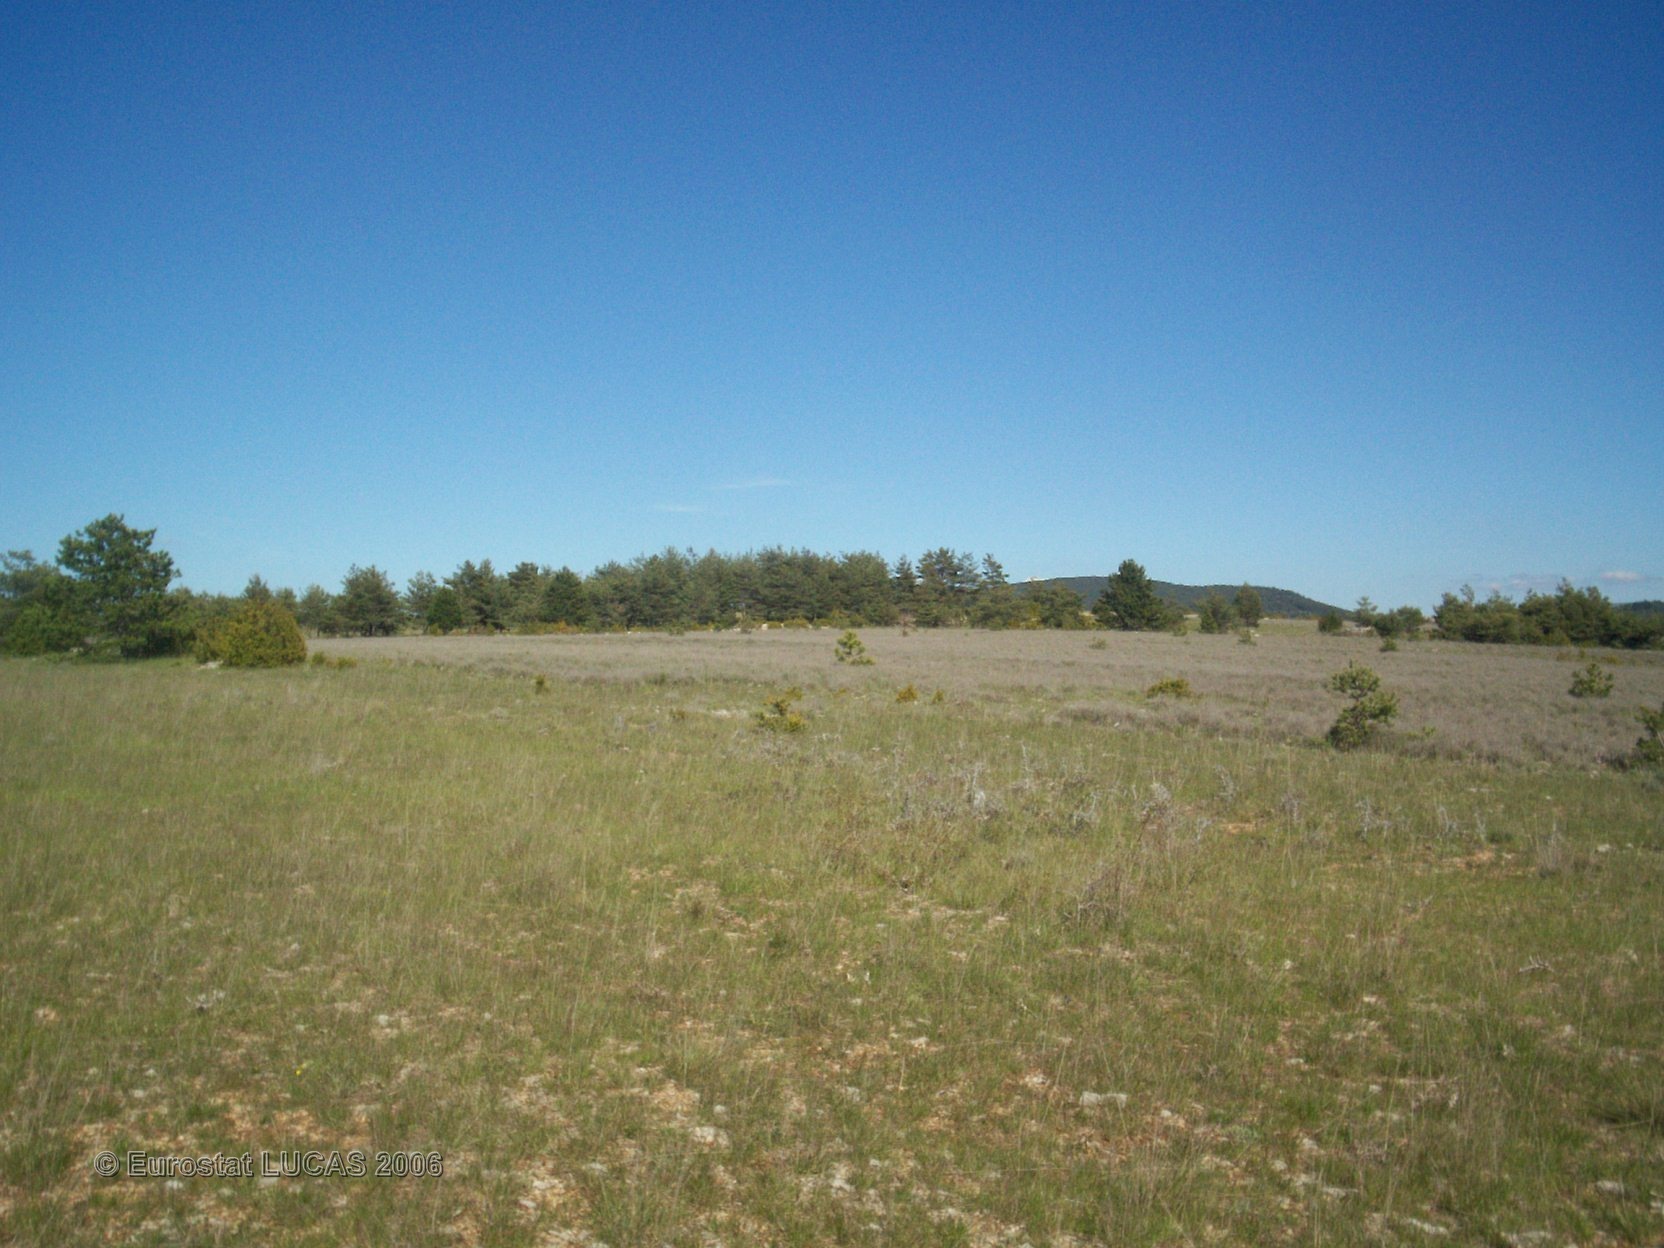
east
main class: Grassland
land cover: Grassland without tree/shrub cover
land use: Agriculture (excluding fallow land and kitchen gardens)
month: May
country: FR
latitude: 44.1384
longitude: 3.3689
